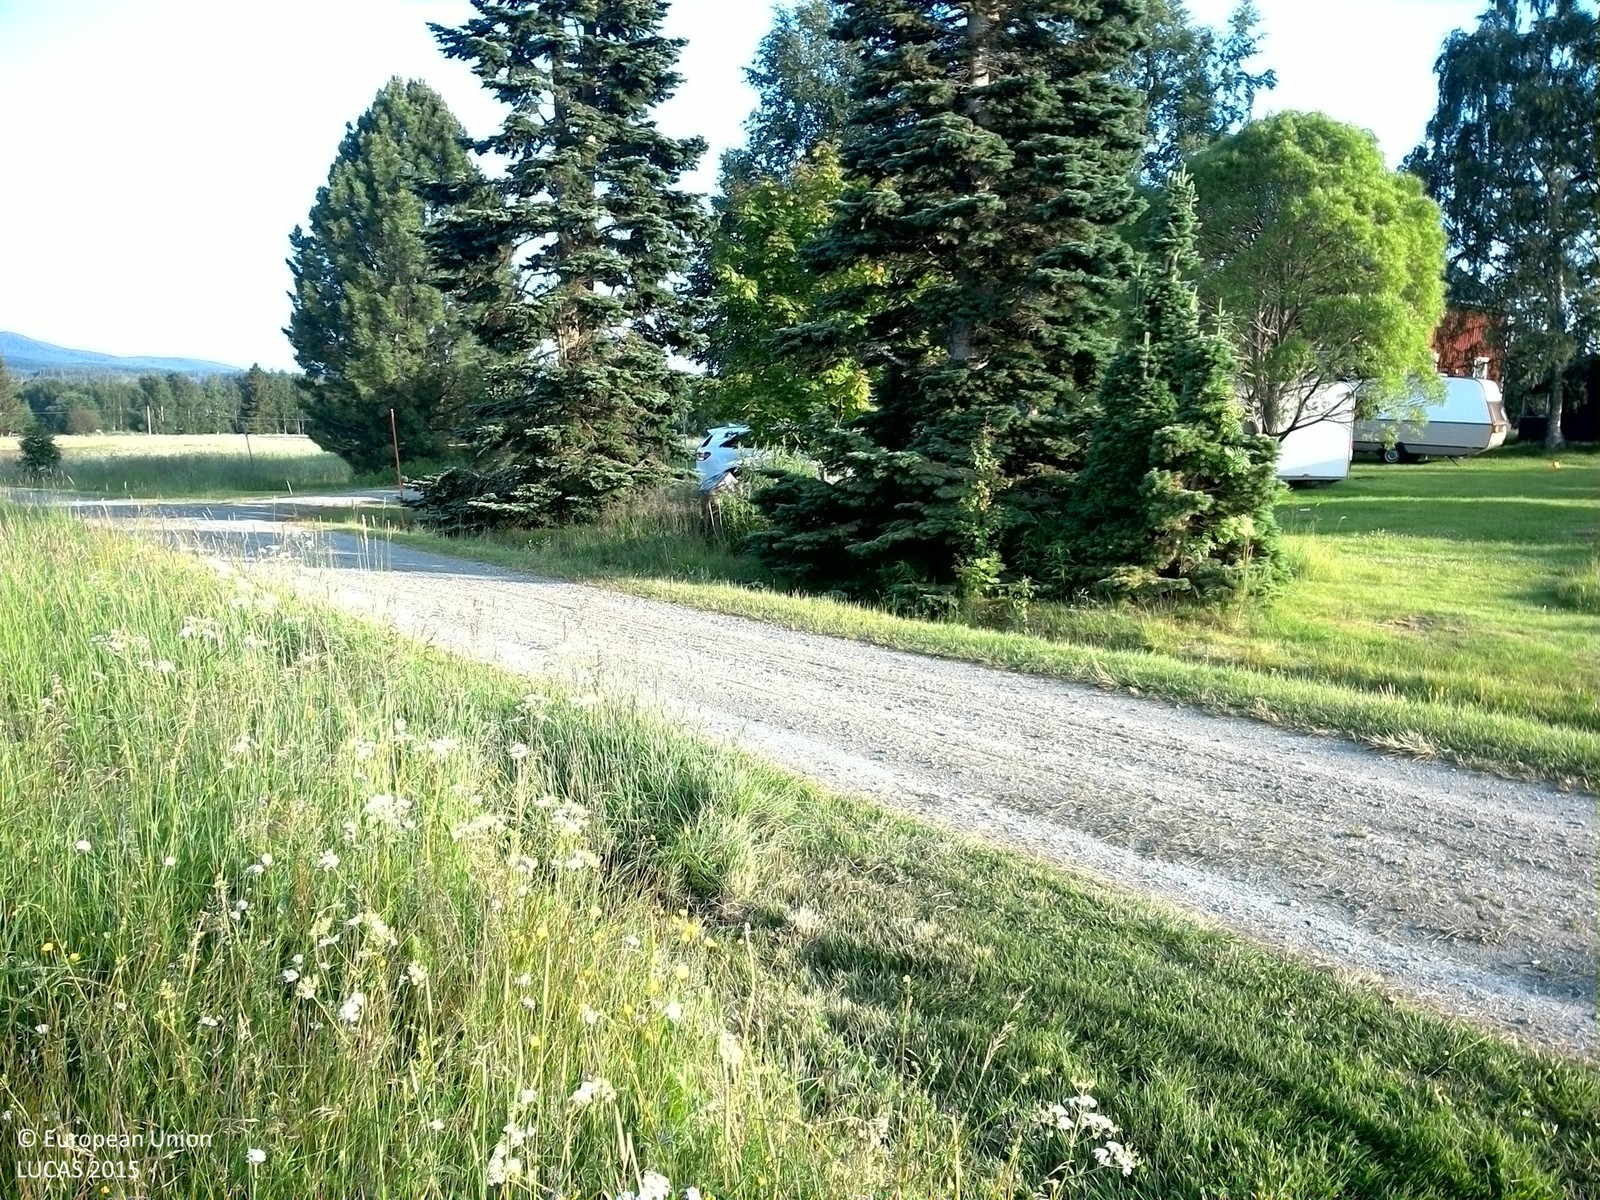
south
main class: Grassland
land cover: Grassland without tree/shrub cover
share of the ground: > 75 %
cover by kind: herbaceous plants 95 %, shrubs 5 %
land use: Residential
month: July
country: SE
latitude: 64.1859
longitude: 16.6590
